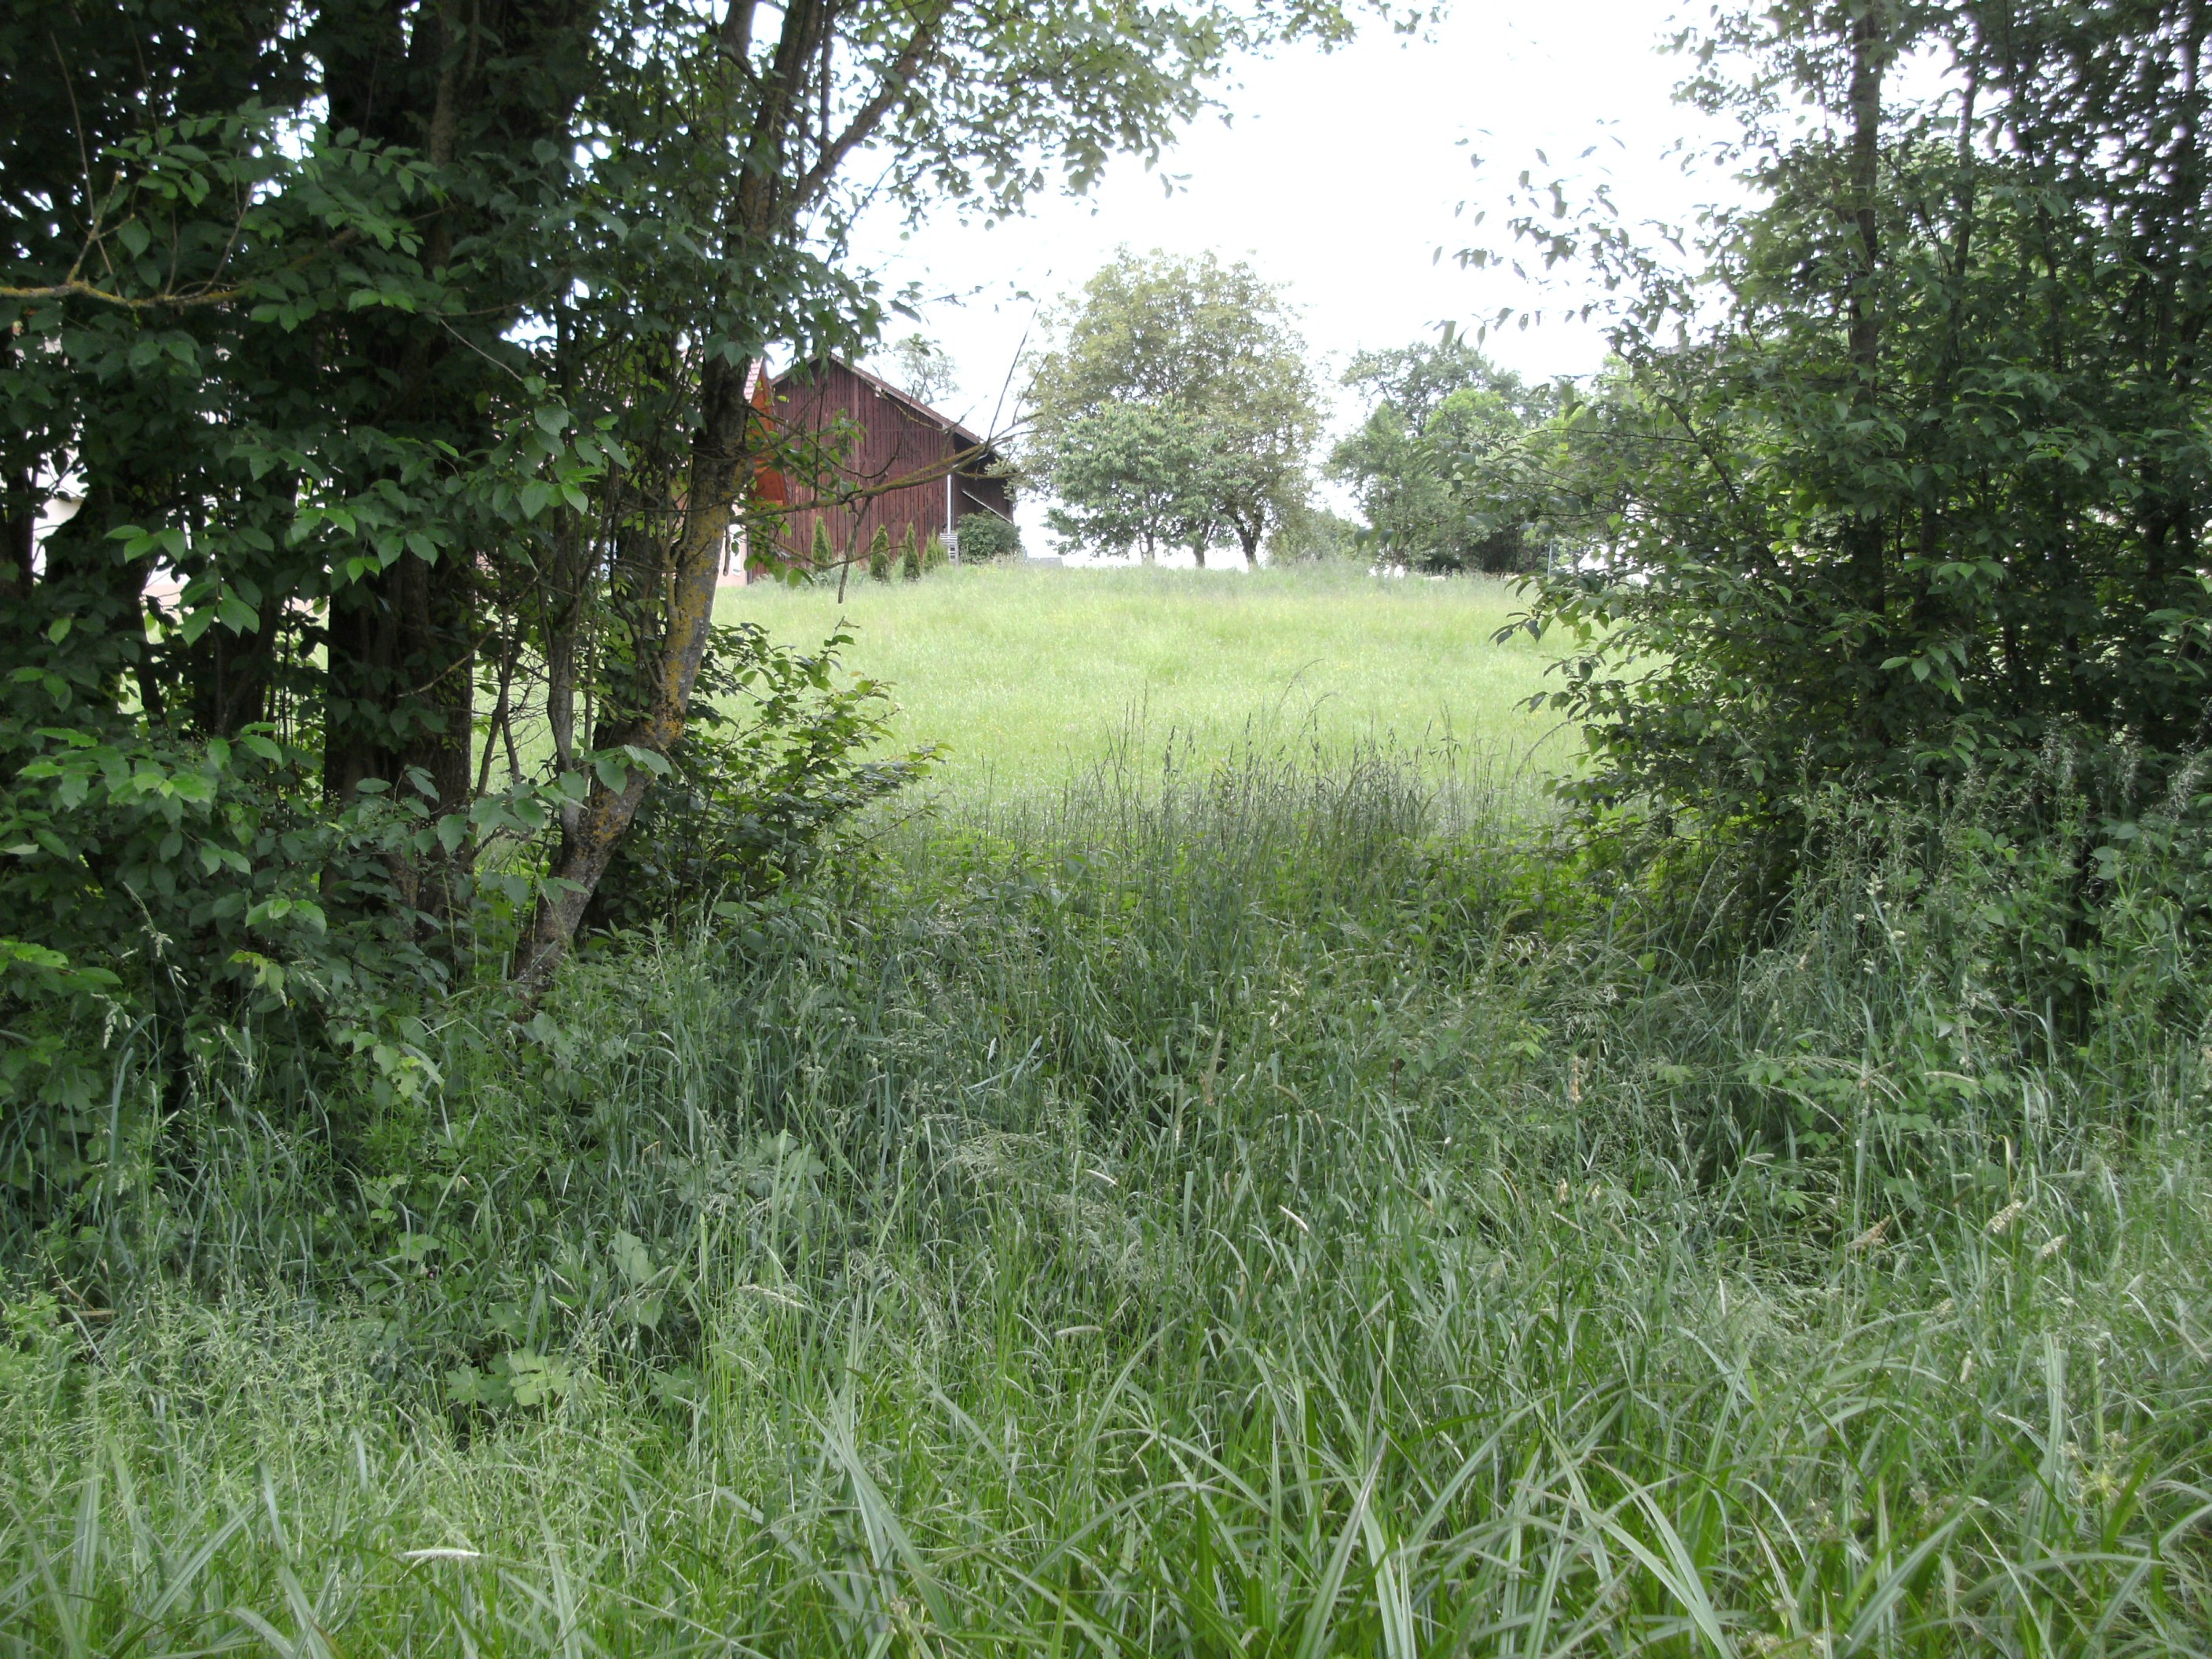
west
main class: Grassland
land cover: Grassland with sparse tree/shrub cover
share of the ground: > 75 %
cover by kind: herbaceous plants 95 %, broadleaved forest trees 5 %
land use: Agriculture (excluding fallow land and kitchen gardens)
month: May
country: AT
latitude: 48.1050
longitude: 13.7731
